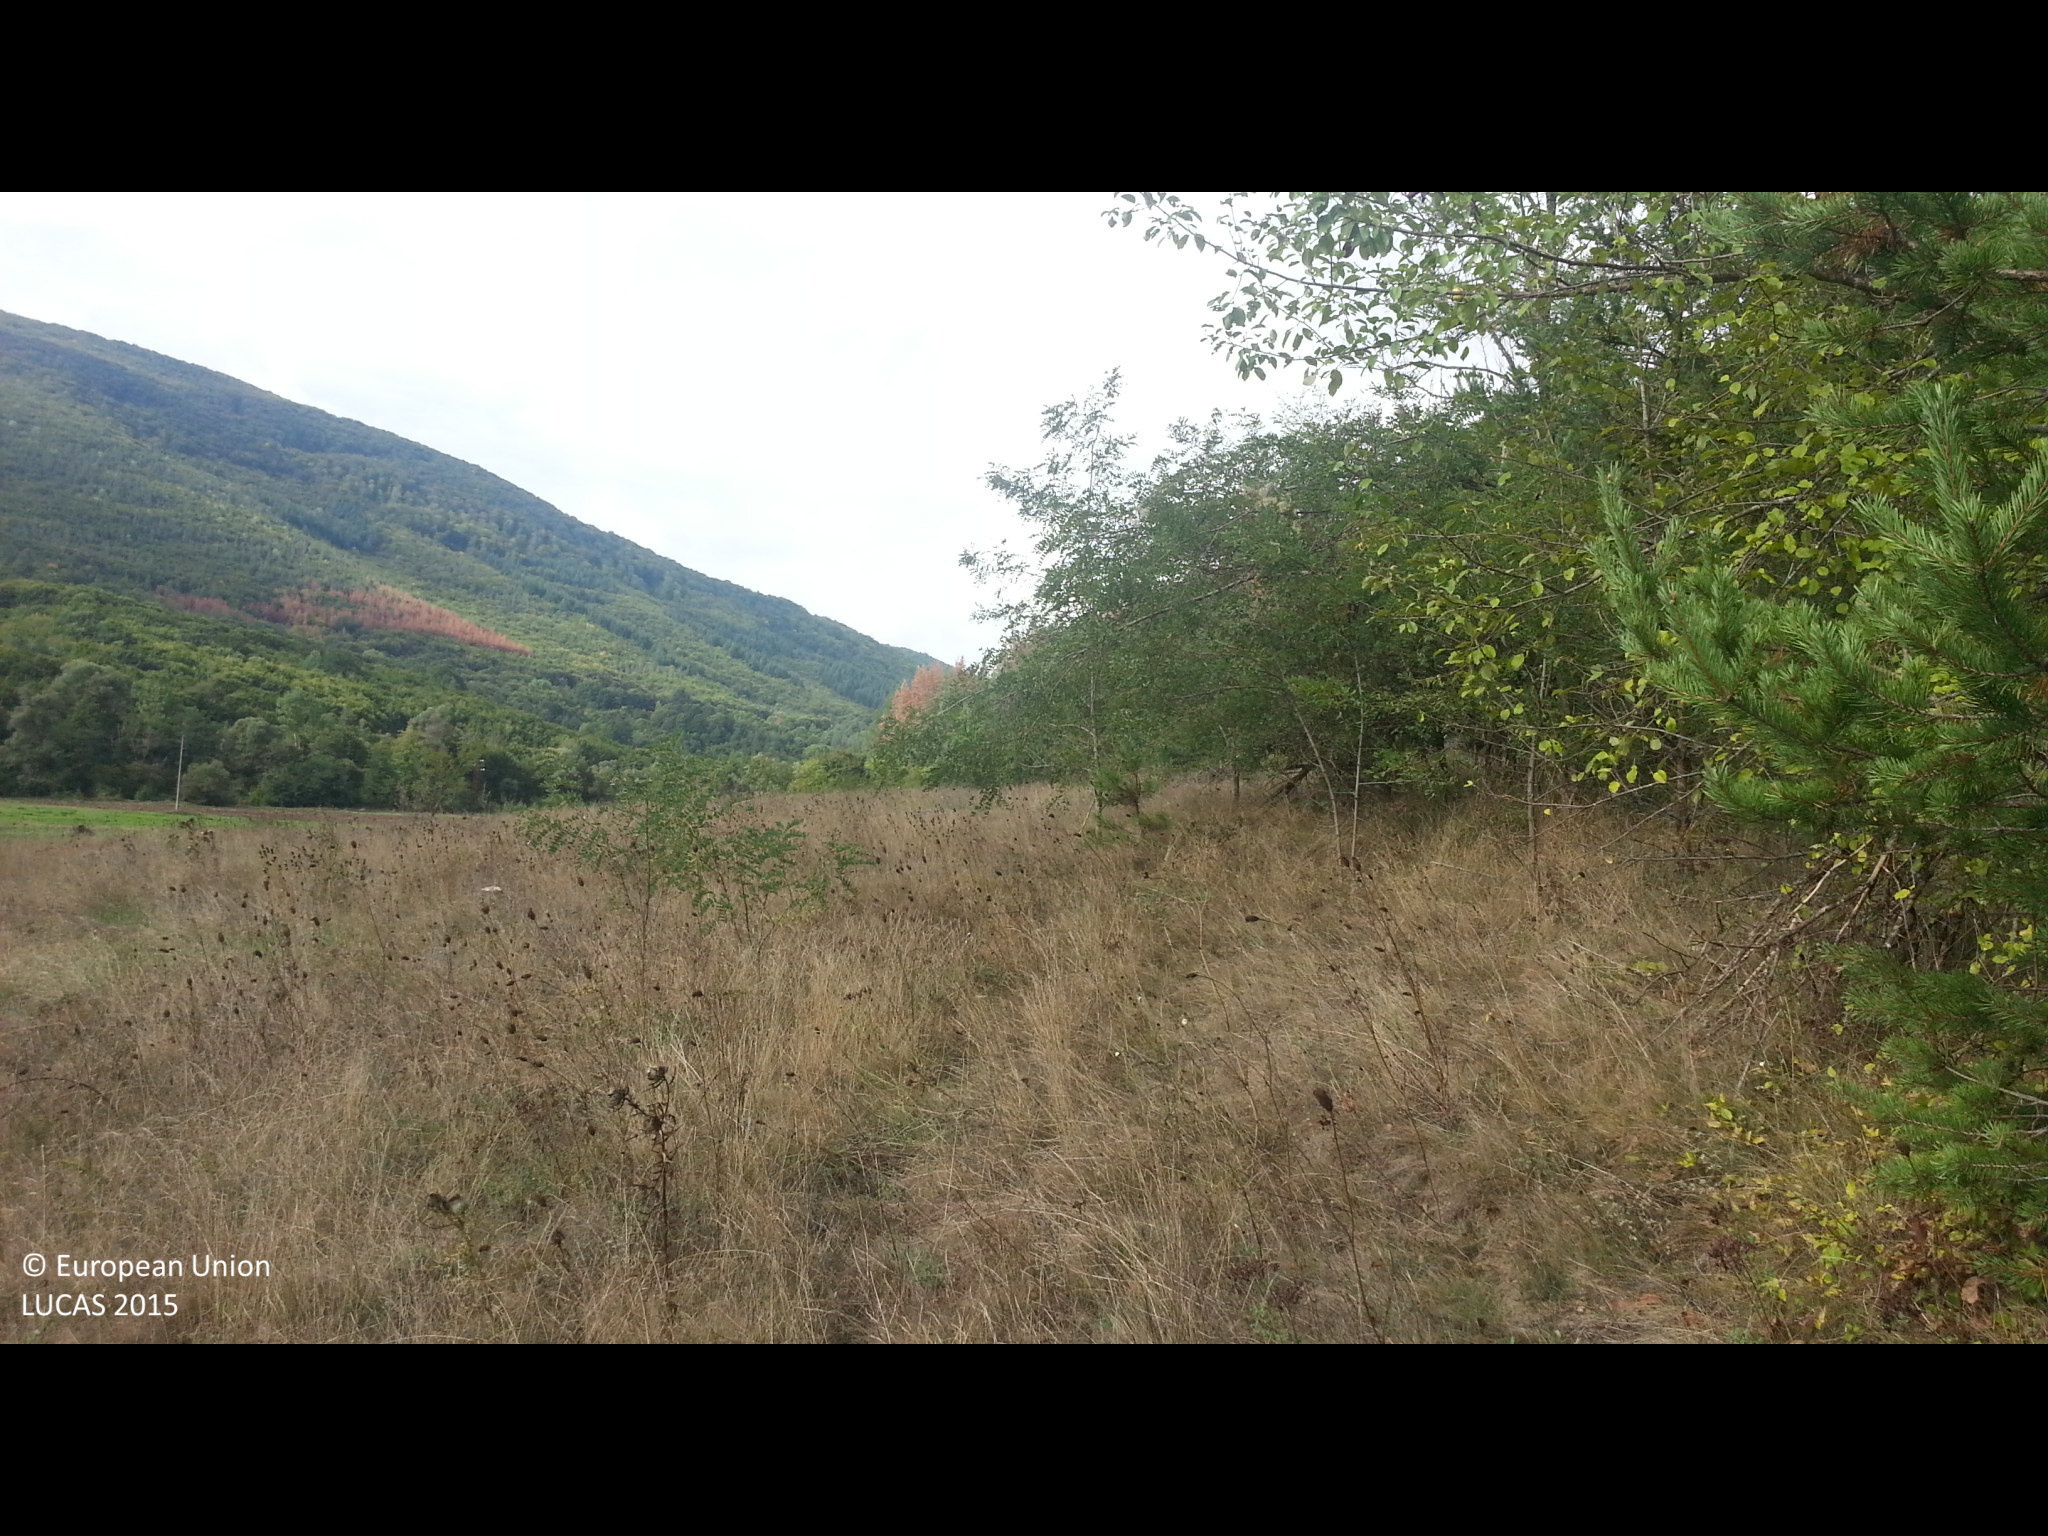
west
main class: Woodland
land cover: Other coniferous woodland
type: hemiboreal forest and nemoral coniferous forest and mixed broadleaved-coniferous forest
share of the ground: > 75 %
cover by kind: coniferous forest trees 100 %
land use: Forestry
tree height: > 5 m
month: September
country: BG
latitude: 42.5598
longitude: 22.5807
